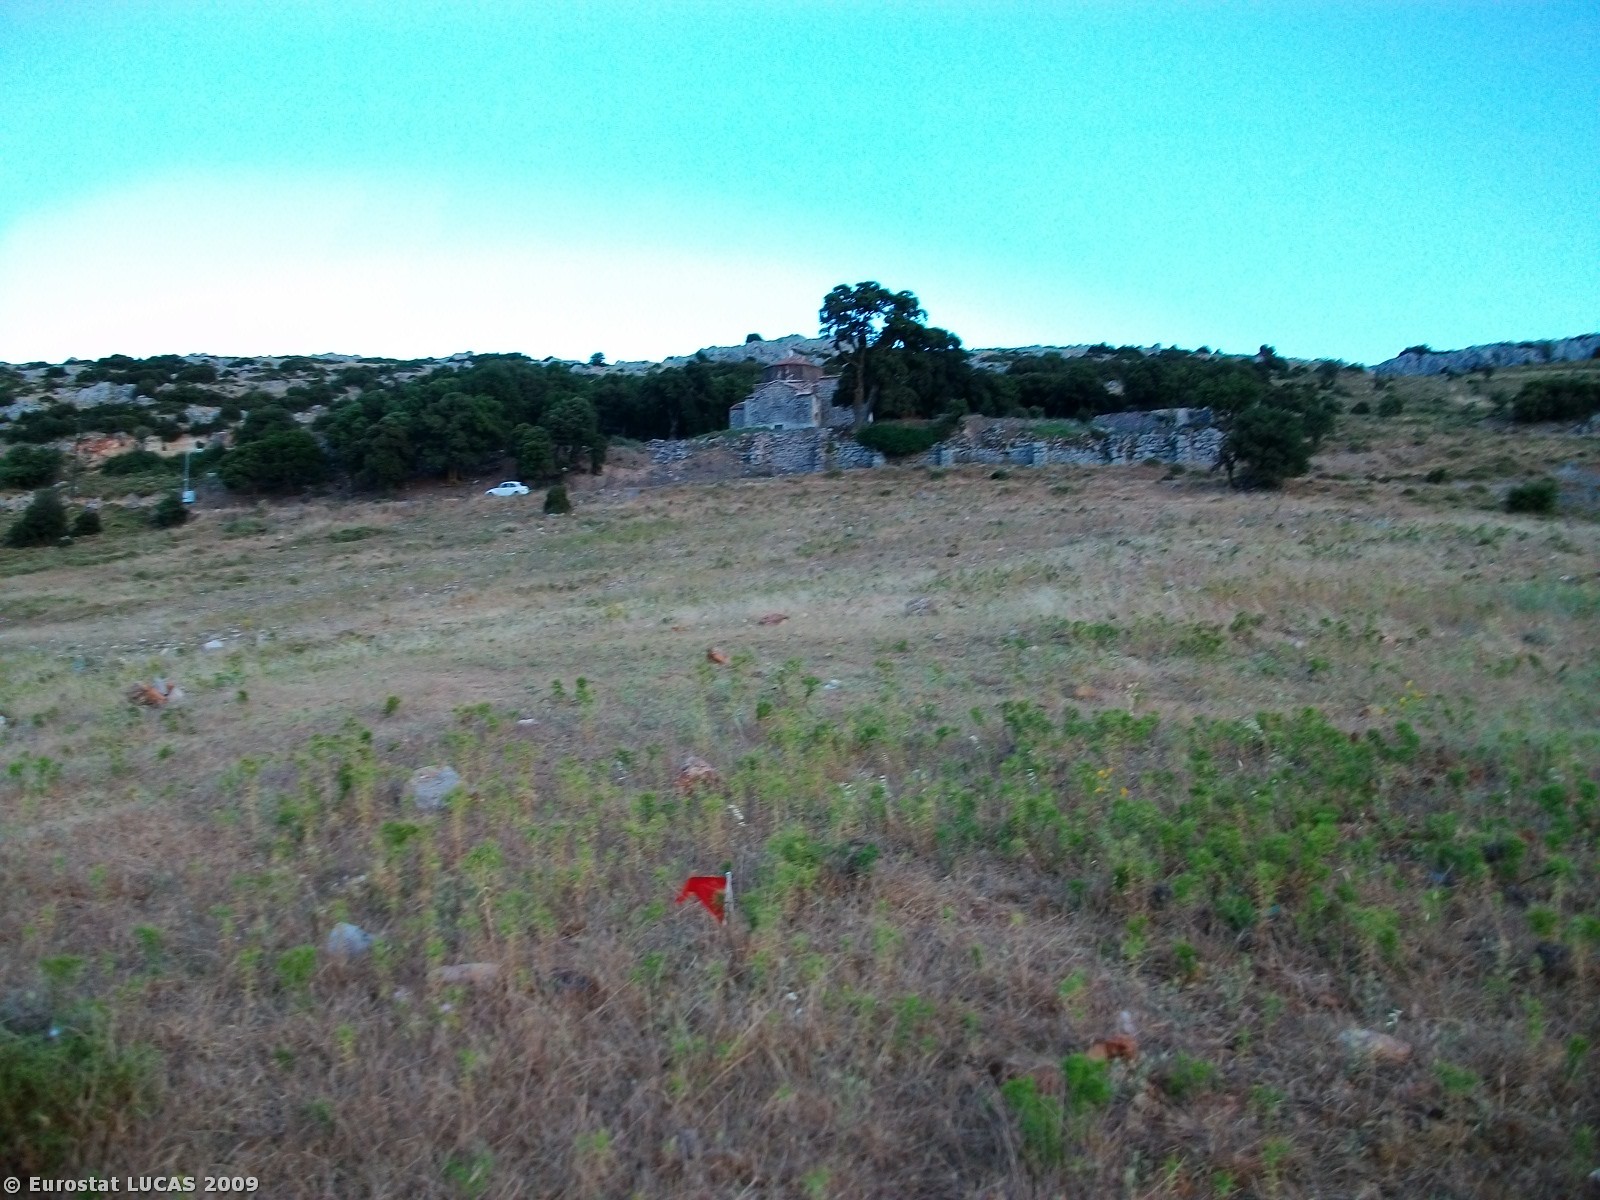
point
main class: Grassland
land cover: Grassland with sparse tree/shrub cover
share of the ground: > 75 %
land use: Agriculture (excluding fallow land and kitchen gardens)
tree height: < 5 m
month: June
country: GR
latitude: 38.2157
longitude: 23.4700
